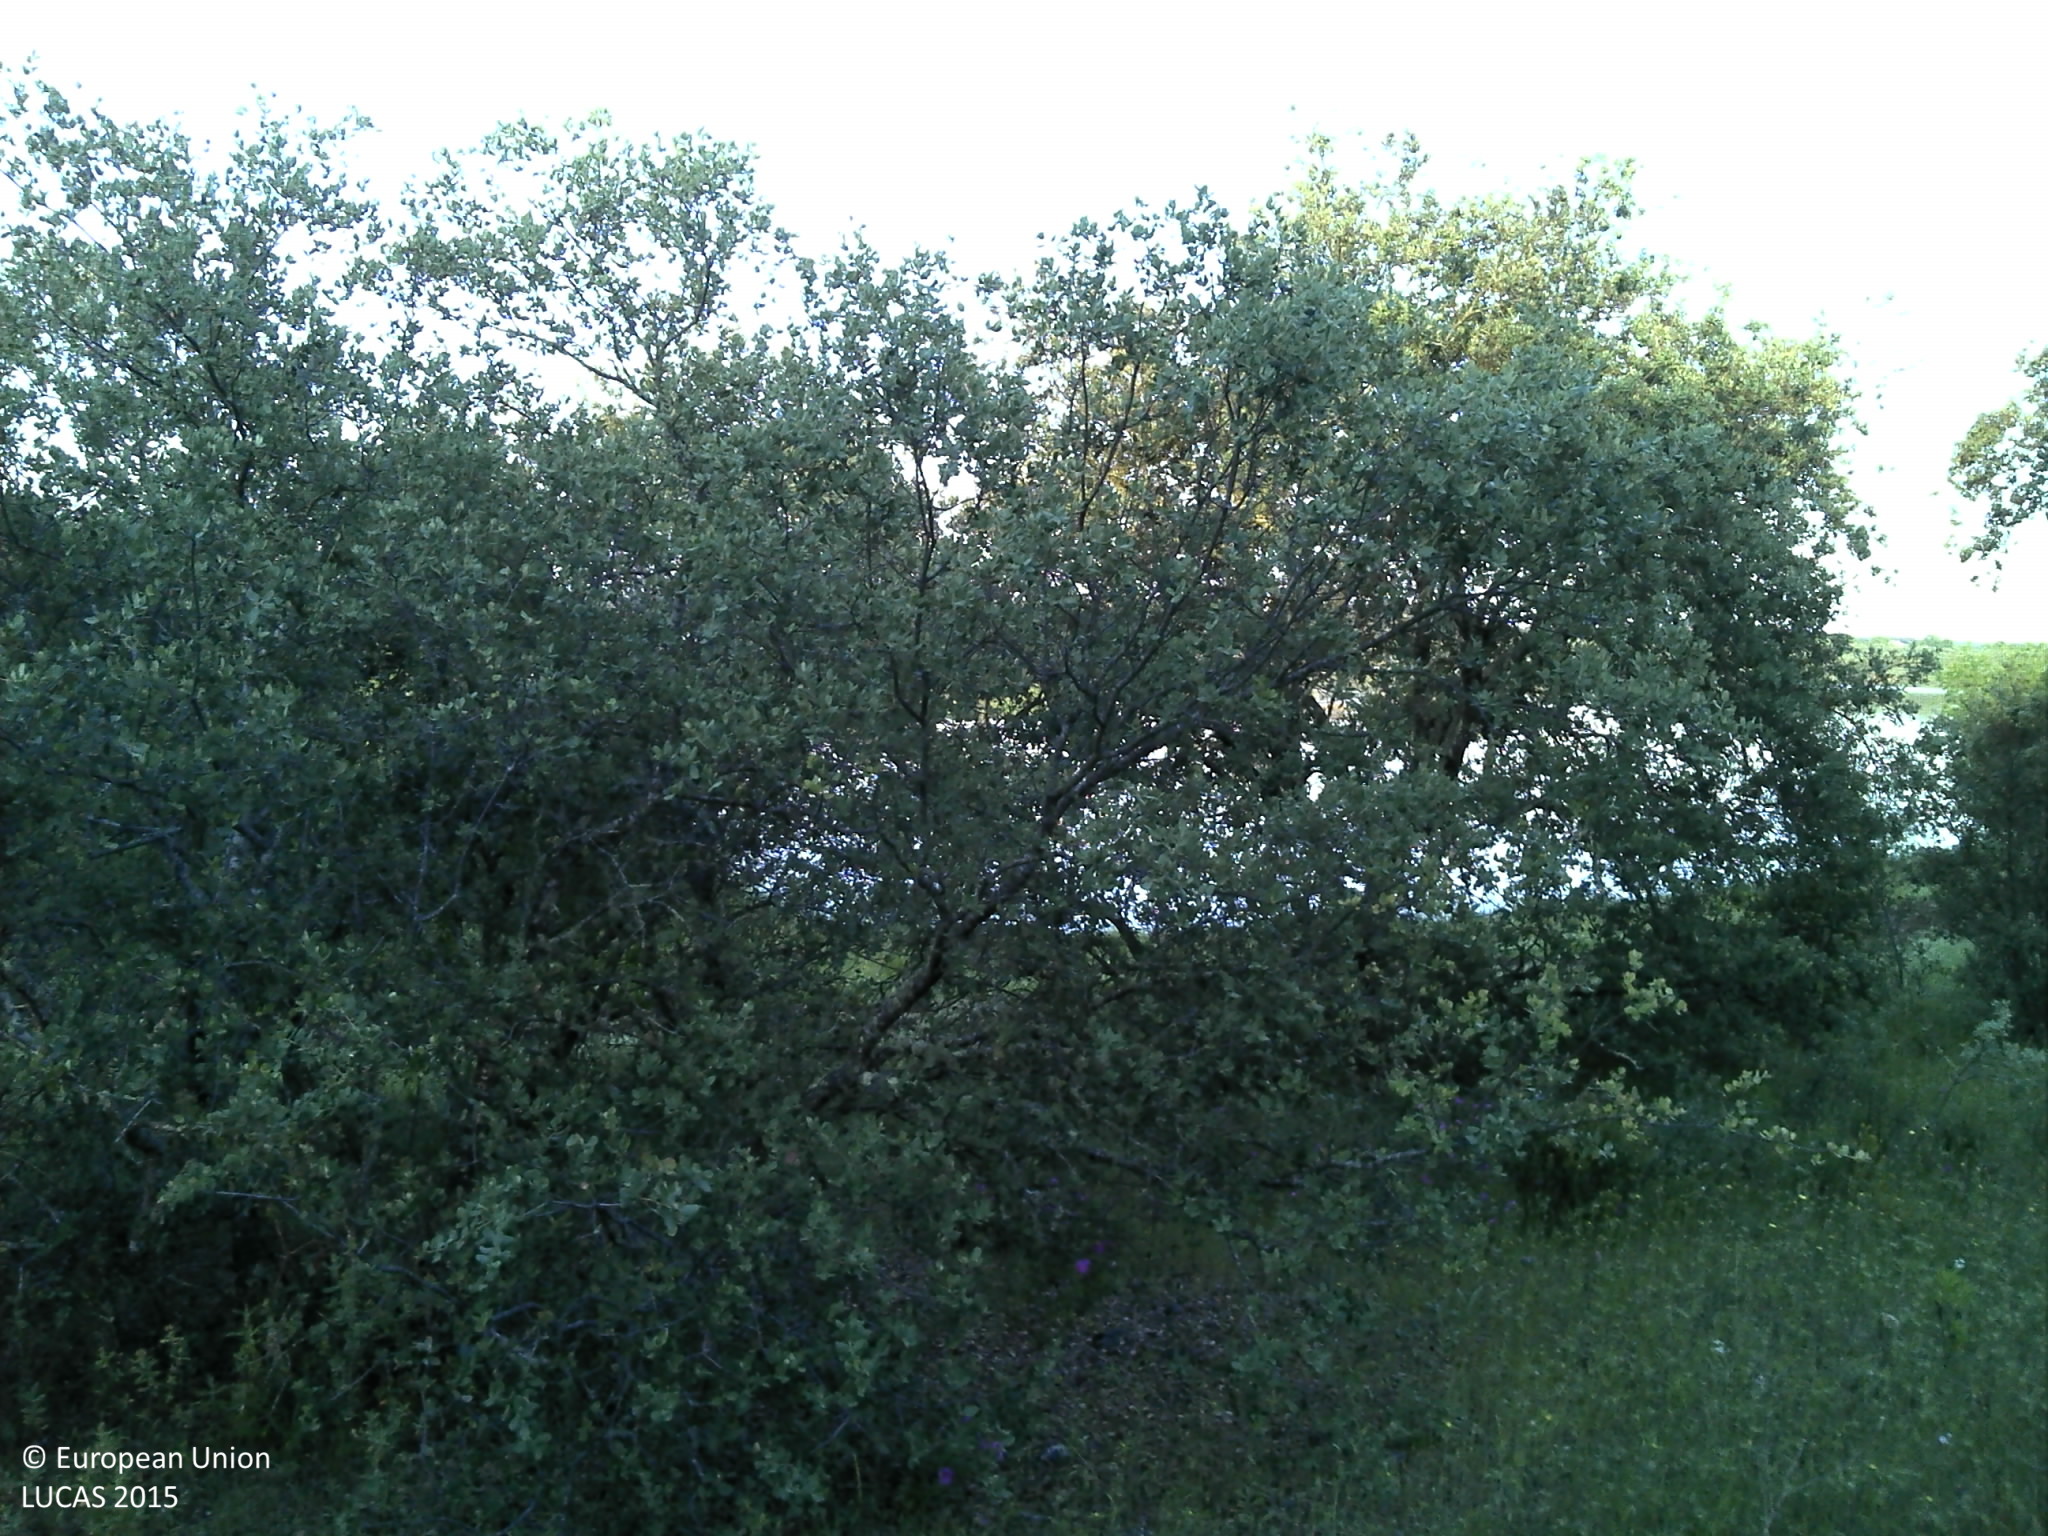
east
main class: Woodland
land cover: Broadleaved woodland
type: broadleaved evergreen forest
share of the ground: 25 - 50 %
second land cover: Grassland without tree/shrub cover
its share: 50 - 75 %
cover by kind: herbaceous plants 50 %, broadleaved forest trees 30 %, unconsolidated bare surface 15 %, shrubs 5 %
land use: Forestry
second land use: Agriculture (excluding fallow land and kitchen gardens)
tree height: > 5 m
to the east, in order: Broadleaved woodland; Grassland without tree/shrub cover; Other bare soil; Grassland without tree/shrub cover; Inland fresh water bodies
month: May
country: PT
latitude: 39.1063
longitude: -7.8925
